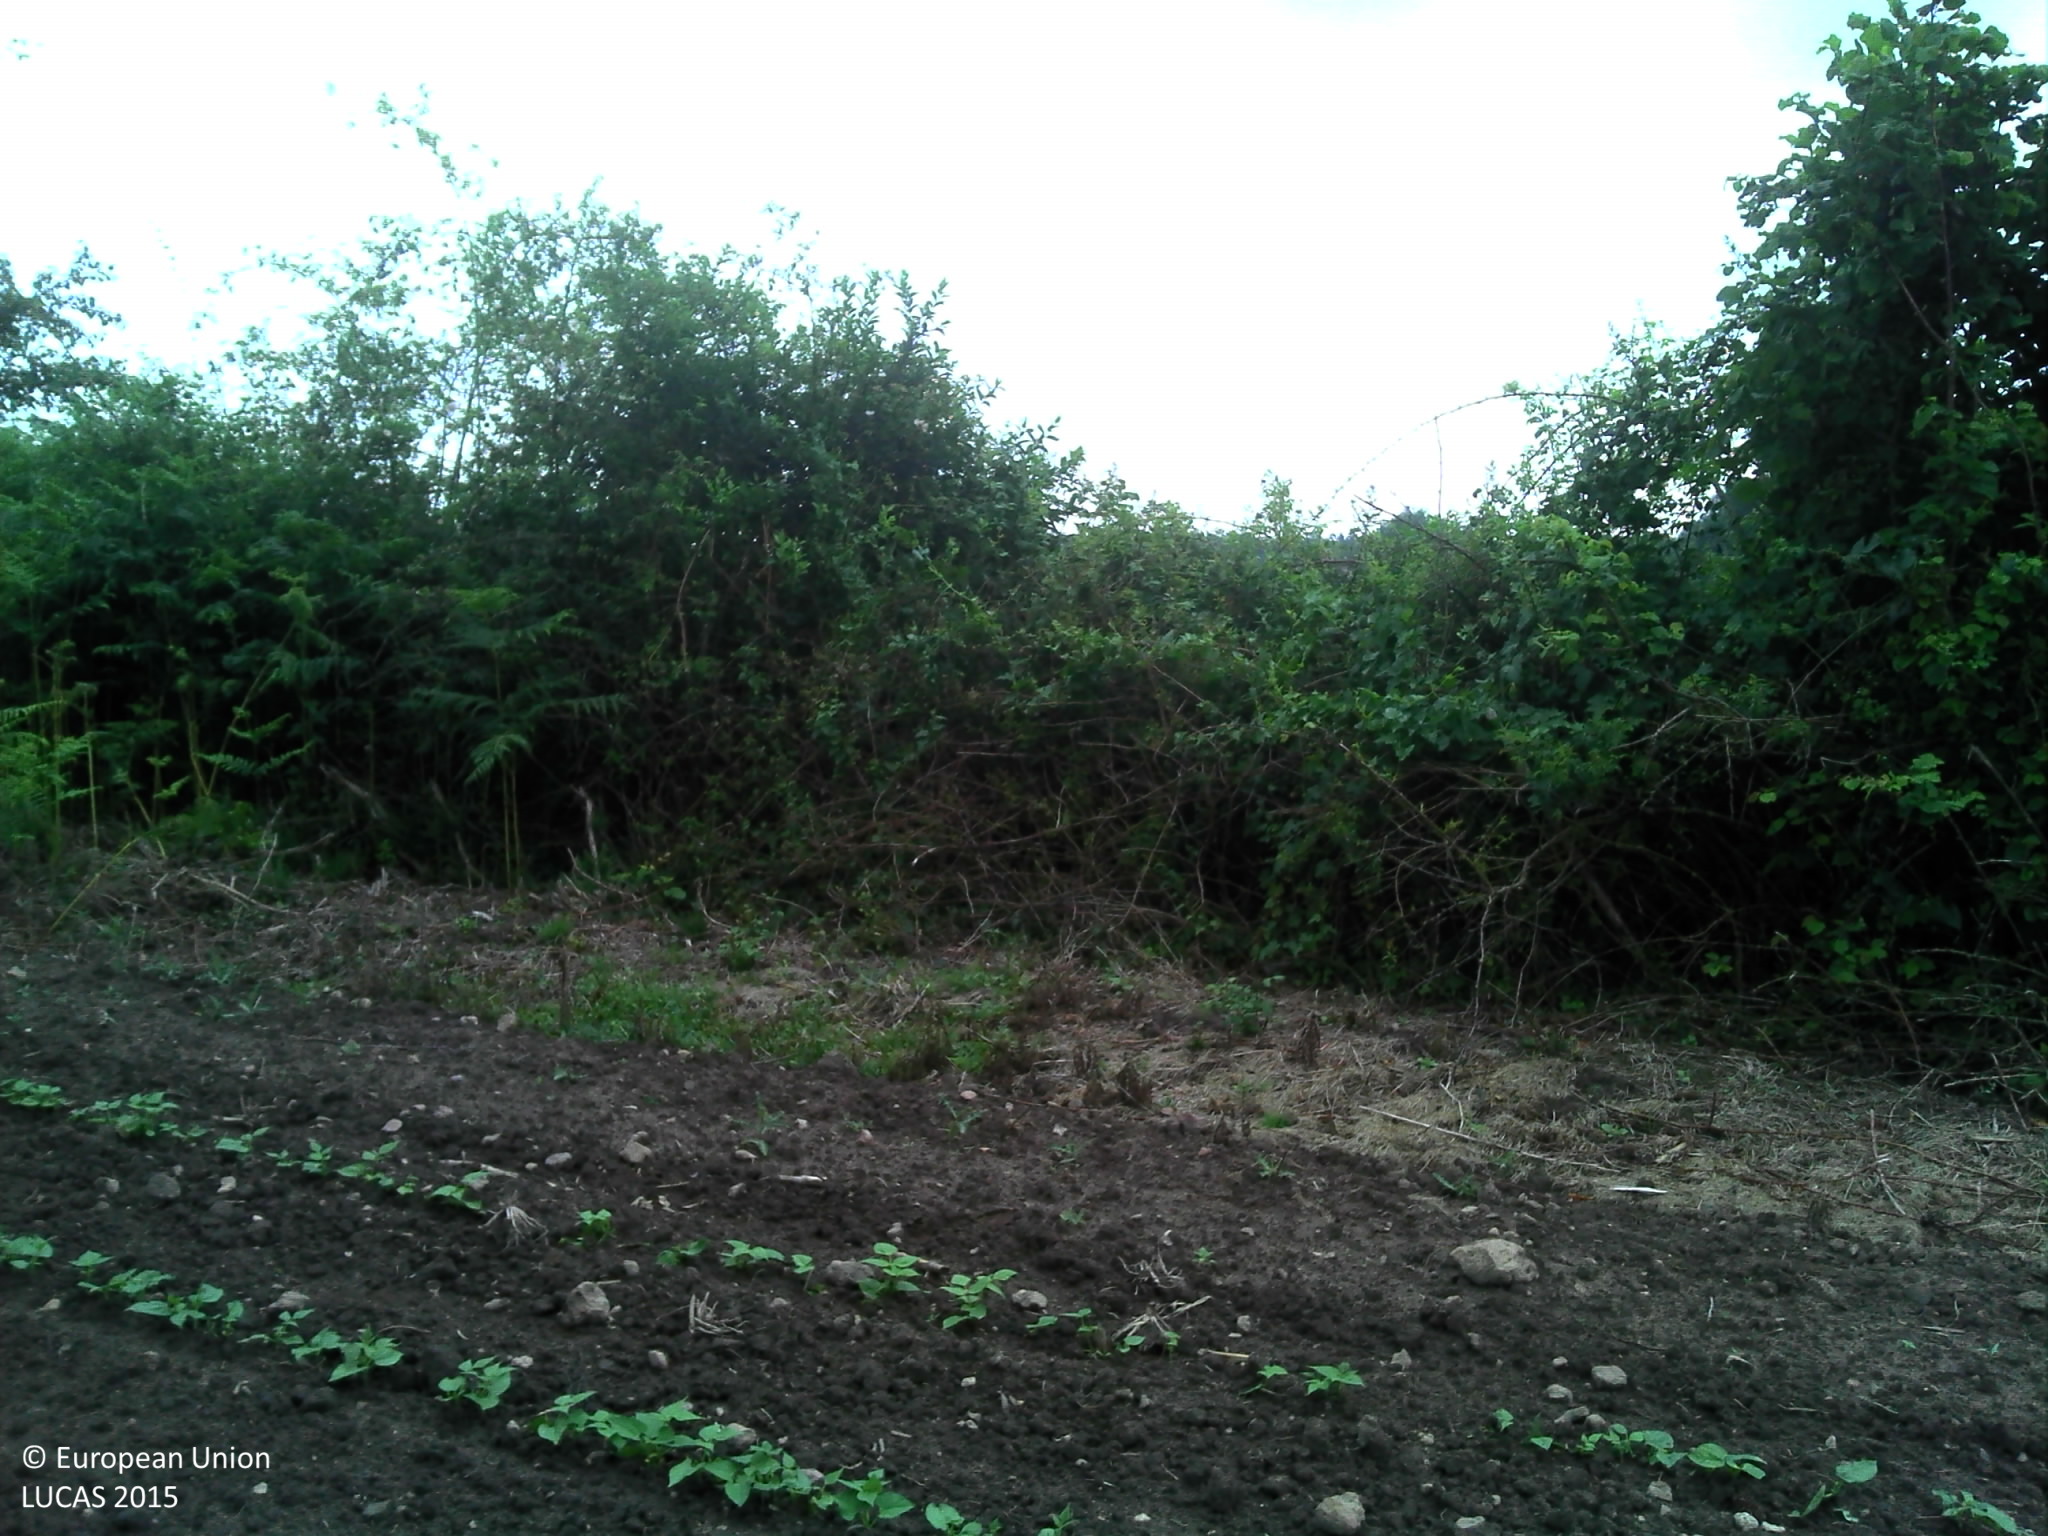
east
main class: Cropland
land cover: Dry pulses
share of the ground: 10 - 25 %
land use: Agriculture (excluding fallow land and kitchen gardens)
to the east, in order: Dry pulses; Grass margins; Abandoned hedges; Maize; Grass margins; Abandoned hedges; Ditches and canals; Grass margins; Maize
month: June
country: FR
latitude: 47.5140
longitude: 0.0016
